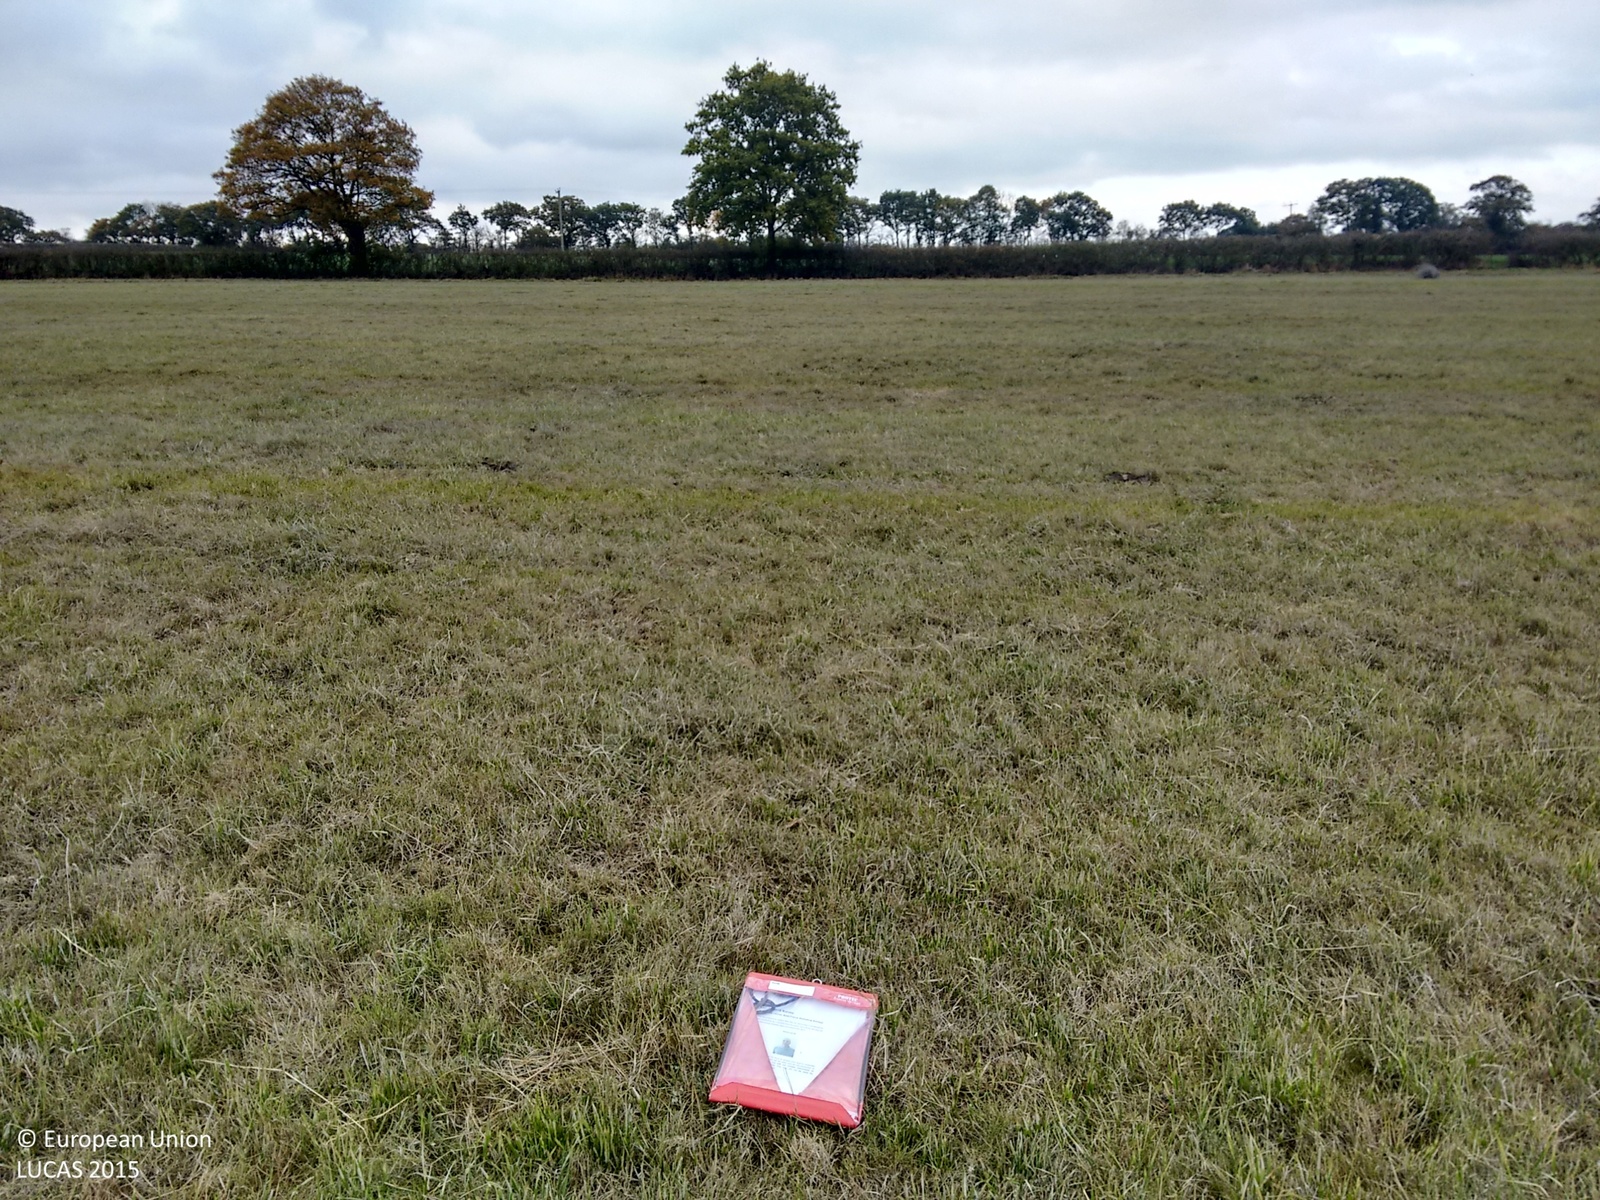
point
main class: Grassland
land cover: Grassland without tree/shrub cover
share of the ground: > 75 %
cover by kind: herbaceous plants 100 %
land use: Agriculture (excluding fallow land and kitchen gardens)
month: October
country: GB
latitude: 52.5022
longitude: -2.7844
